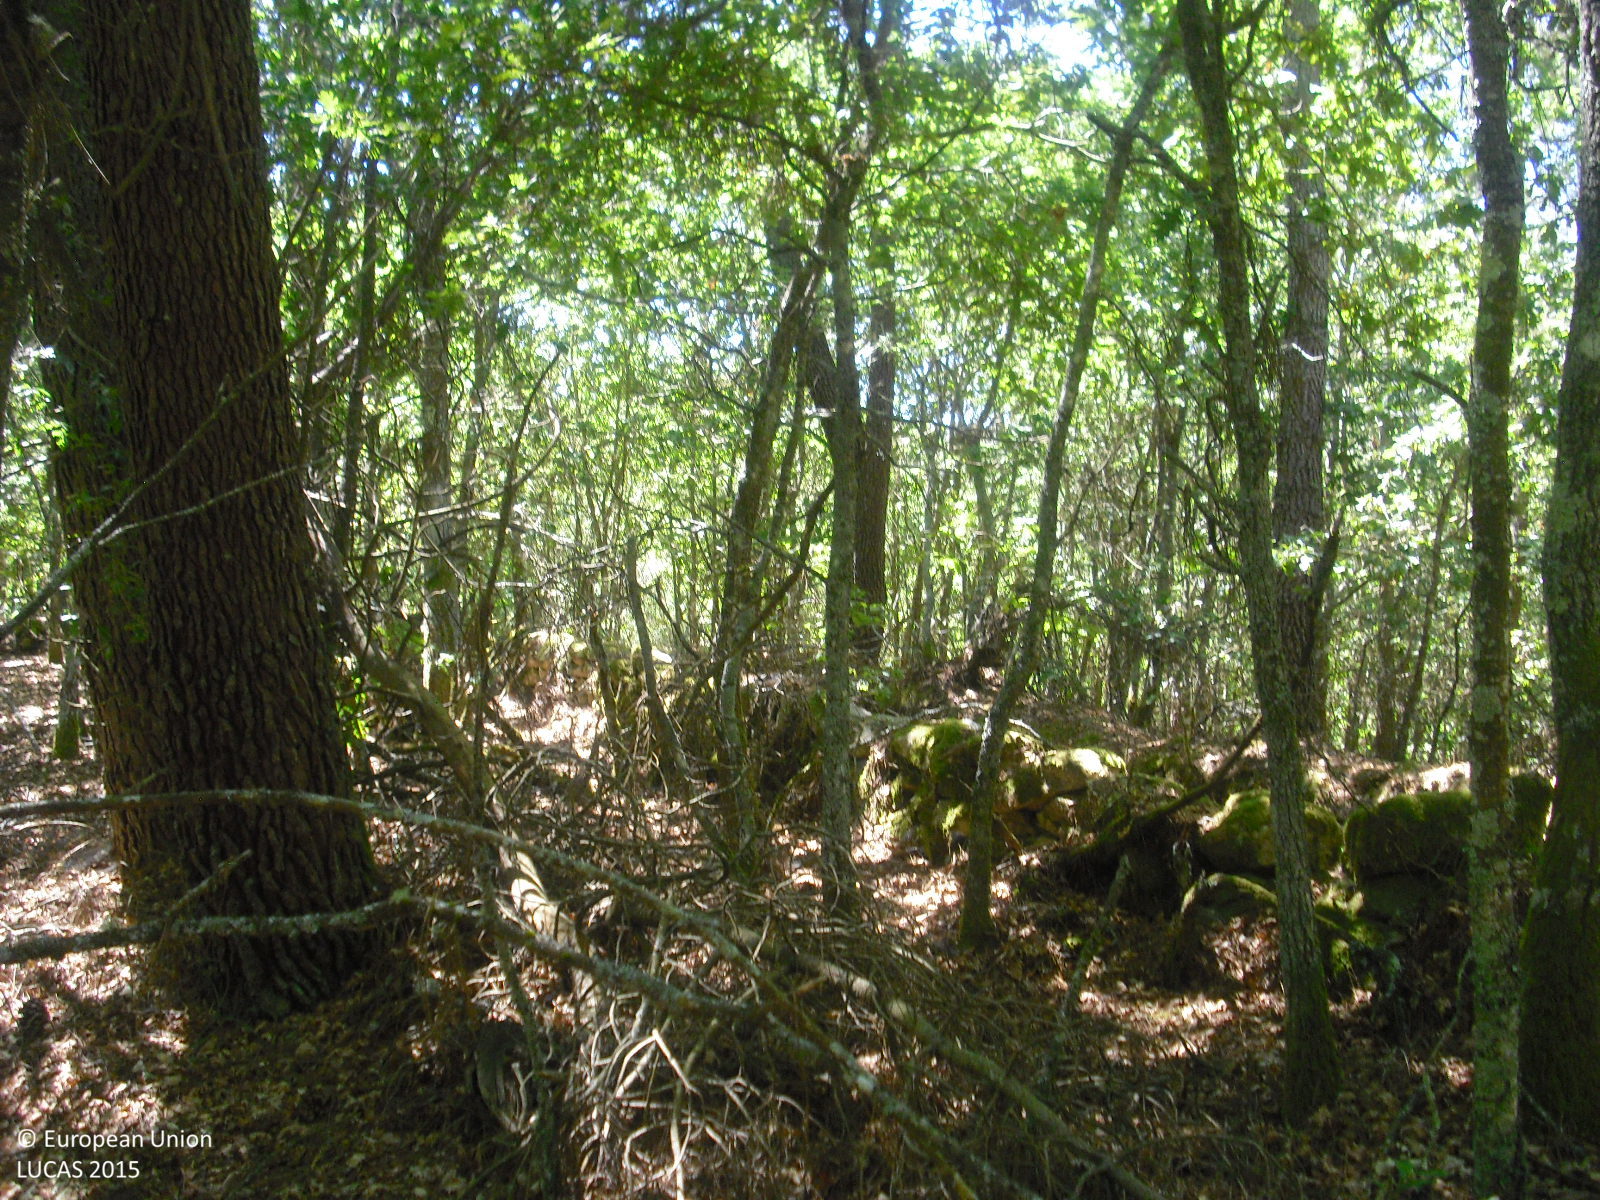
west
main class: Woodland
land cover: Pine dominated mixed woodland
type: hemiboreal forest and nemoral coniferous forest and mixed broadleaved-coniferous forest
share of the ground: > 75 %
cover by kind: broadleaved forest trees 60 %, coniferous forest trees 40 %
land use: Forestry
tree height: > 5 m
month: June
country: ES
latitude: 42.4867
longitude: -7.7781
